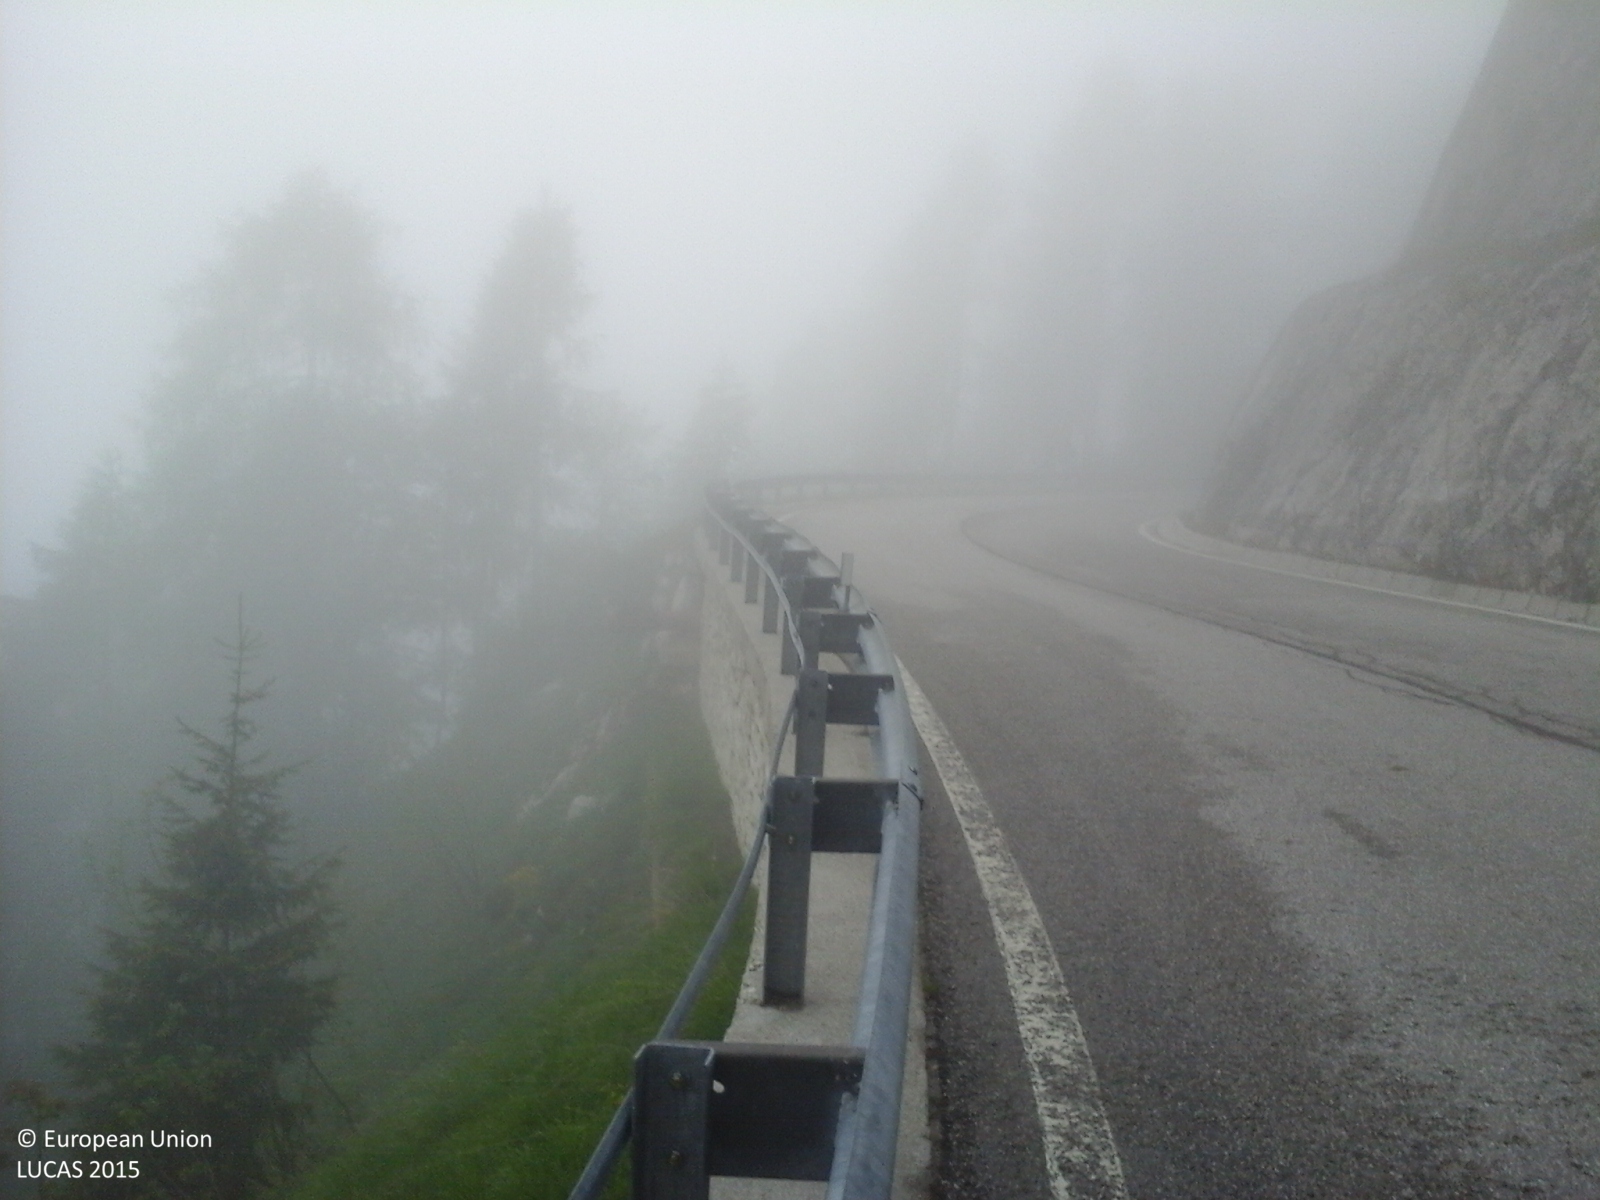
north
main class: Woodland
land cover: Other coniferous woodland
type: alpine coniferous forest
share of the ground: > 75 %
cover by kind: coniferous forest trees 80 %, herbaceous plants 20 %
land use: Forestry
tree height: > 5 m
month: May
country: IT
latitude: 46.1044
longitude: 11.6407
